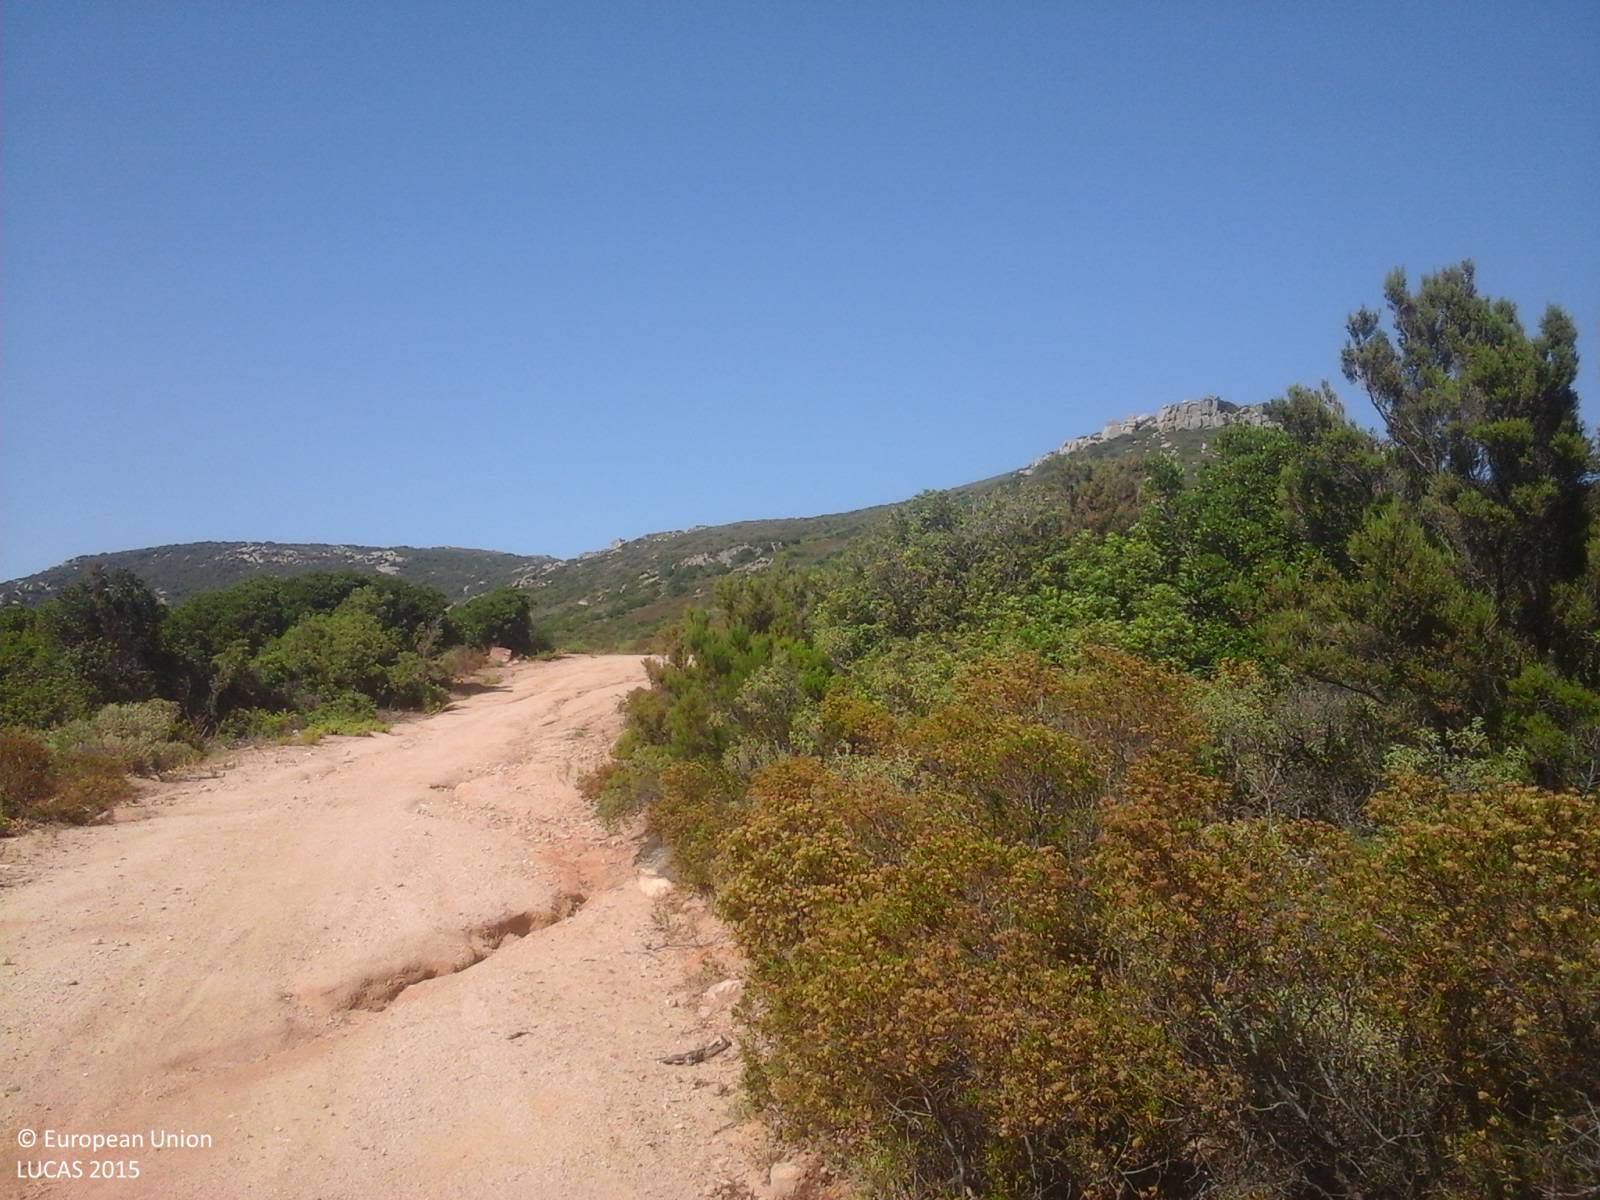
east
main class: Shrubland
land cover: Shrubland without tree cover
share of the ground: > 75 %
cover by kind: shrubs 90 %, herbaceous plants 10 %
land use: Agriculture (excluding fallow land and kitchen gardens)
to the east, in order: Shrubland without tree cover; Tracks; Shrubland without tree cover; Tracks; Shrubland without tree cover
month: June
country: IT
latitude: 39.2150
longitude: 9.4130
